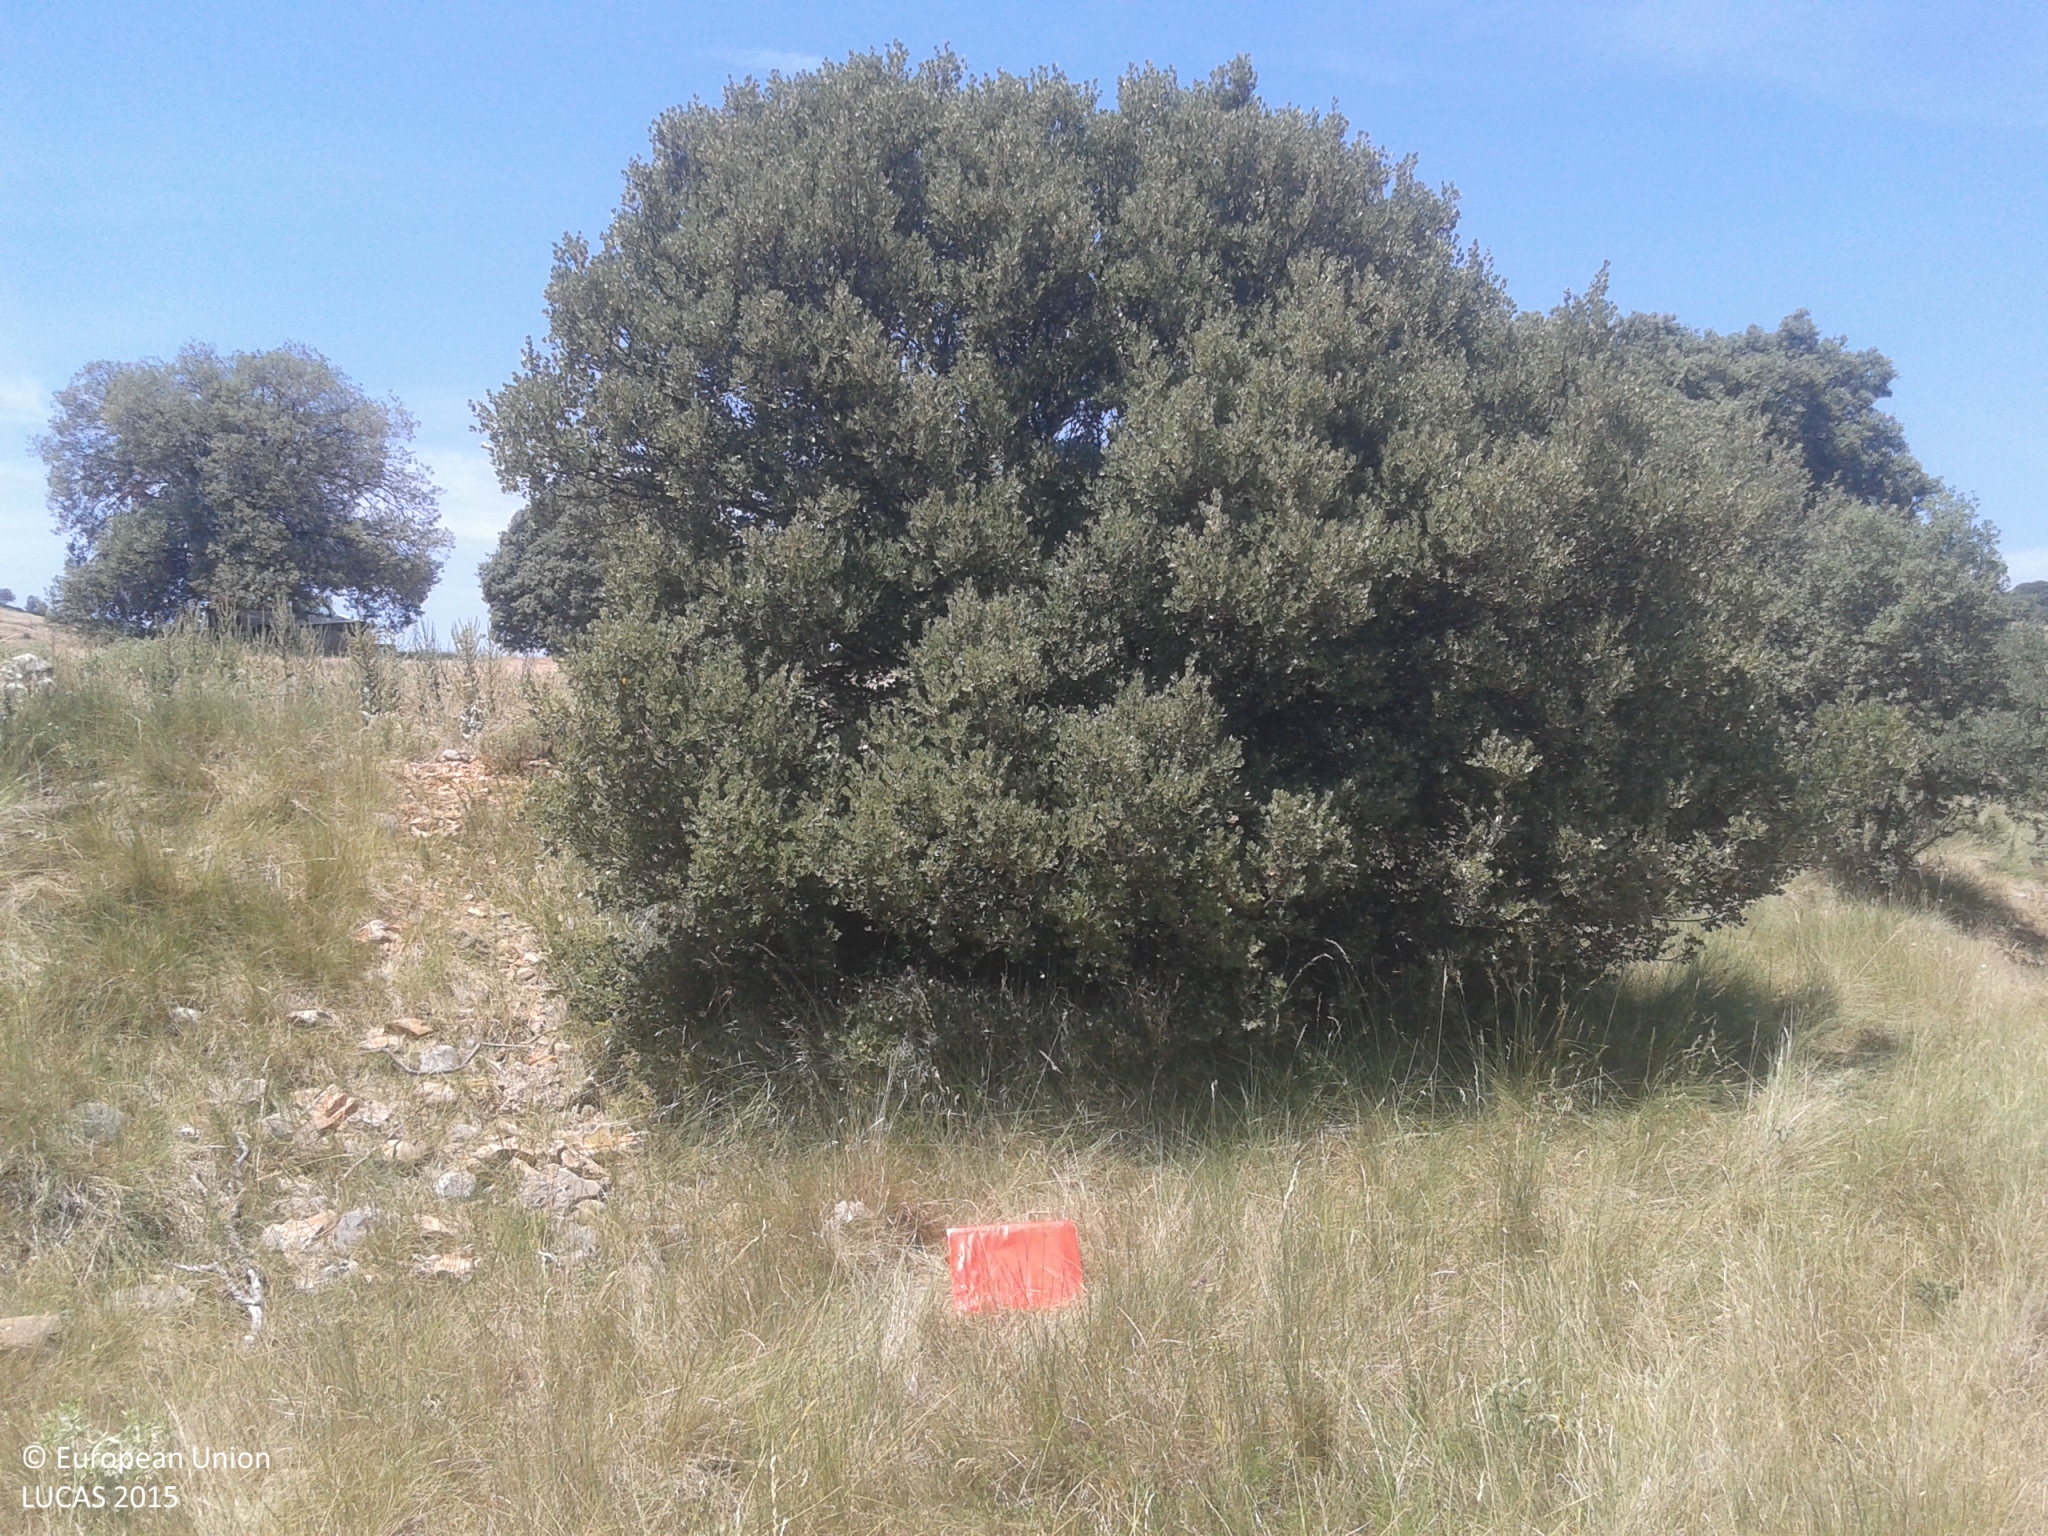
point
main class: Grassland
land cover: Grassland with sparse tree/shrub cover
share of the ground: > 75 %
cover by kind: herbaceous plants 90 %, broadleaved forest trees 5 %, shrubs 5 %
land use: Semi-natural and natural areas not in use
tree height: > 5 m
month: July
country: ES
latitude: 42.0622
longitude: 1.1042
